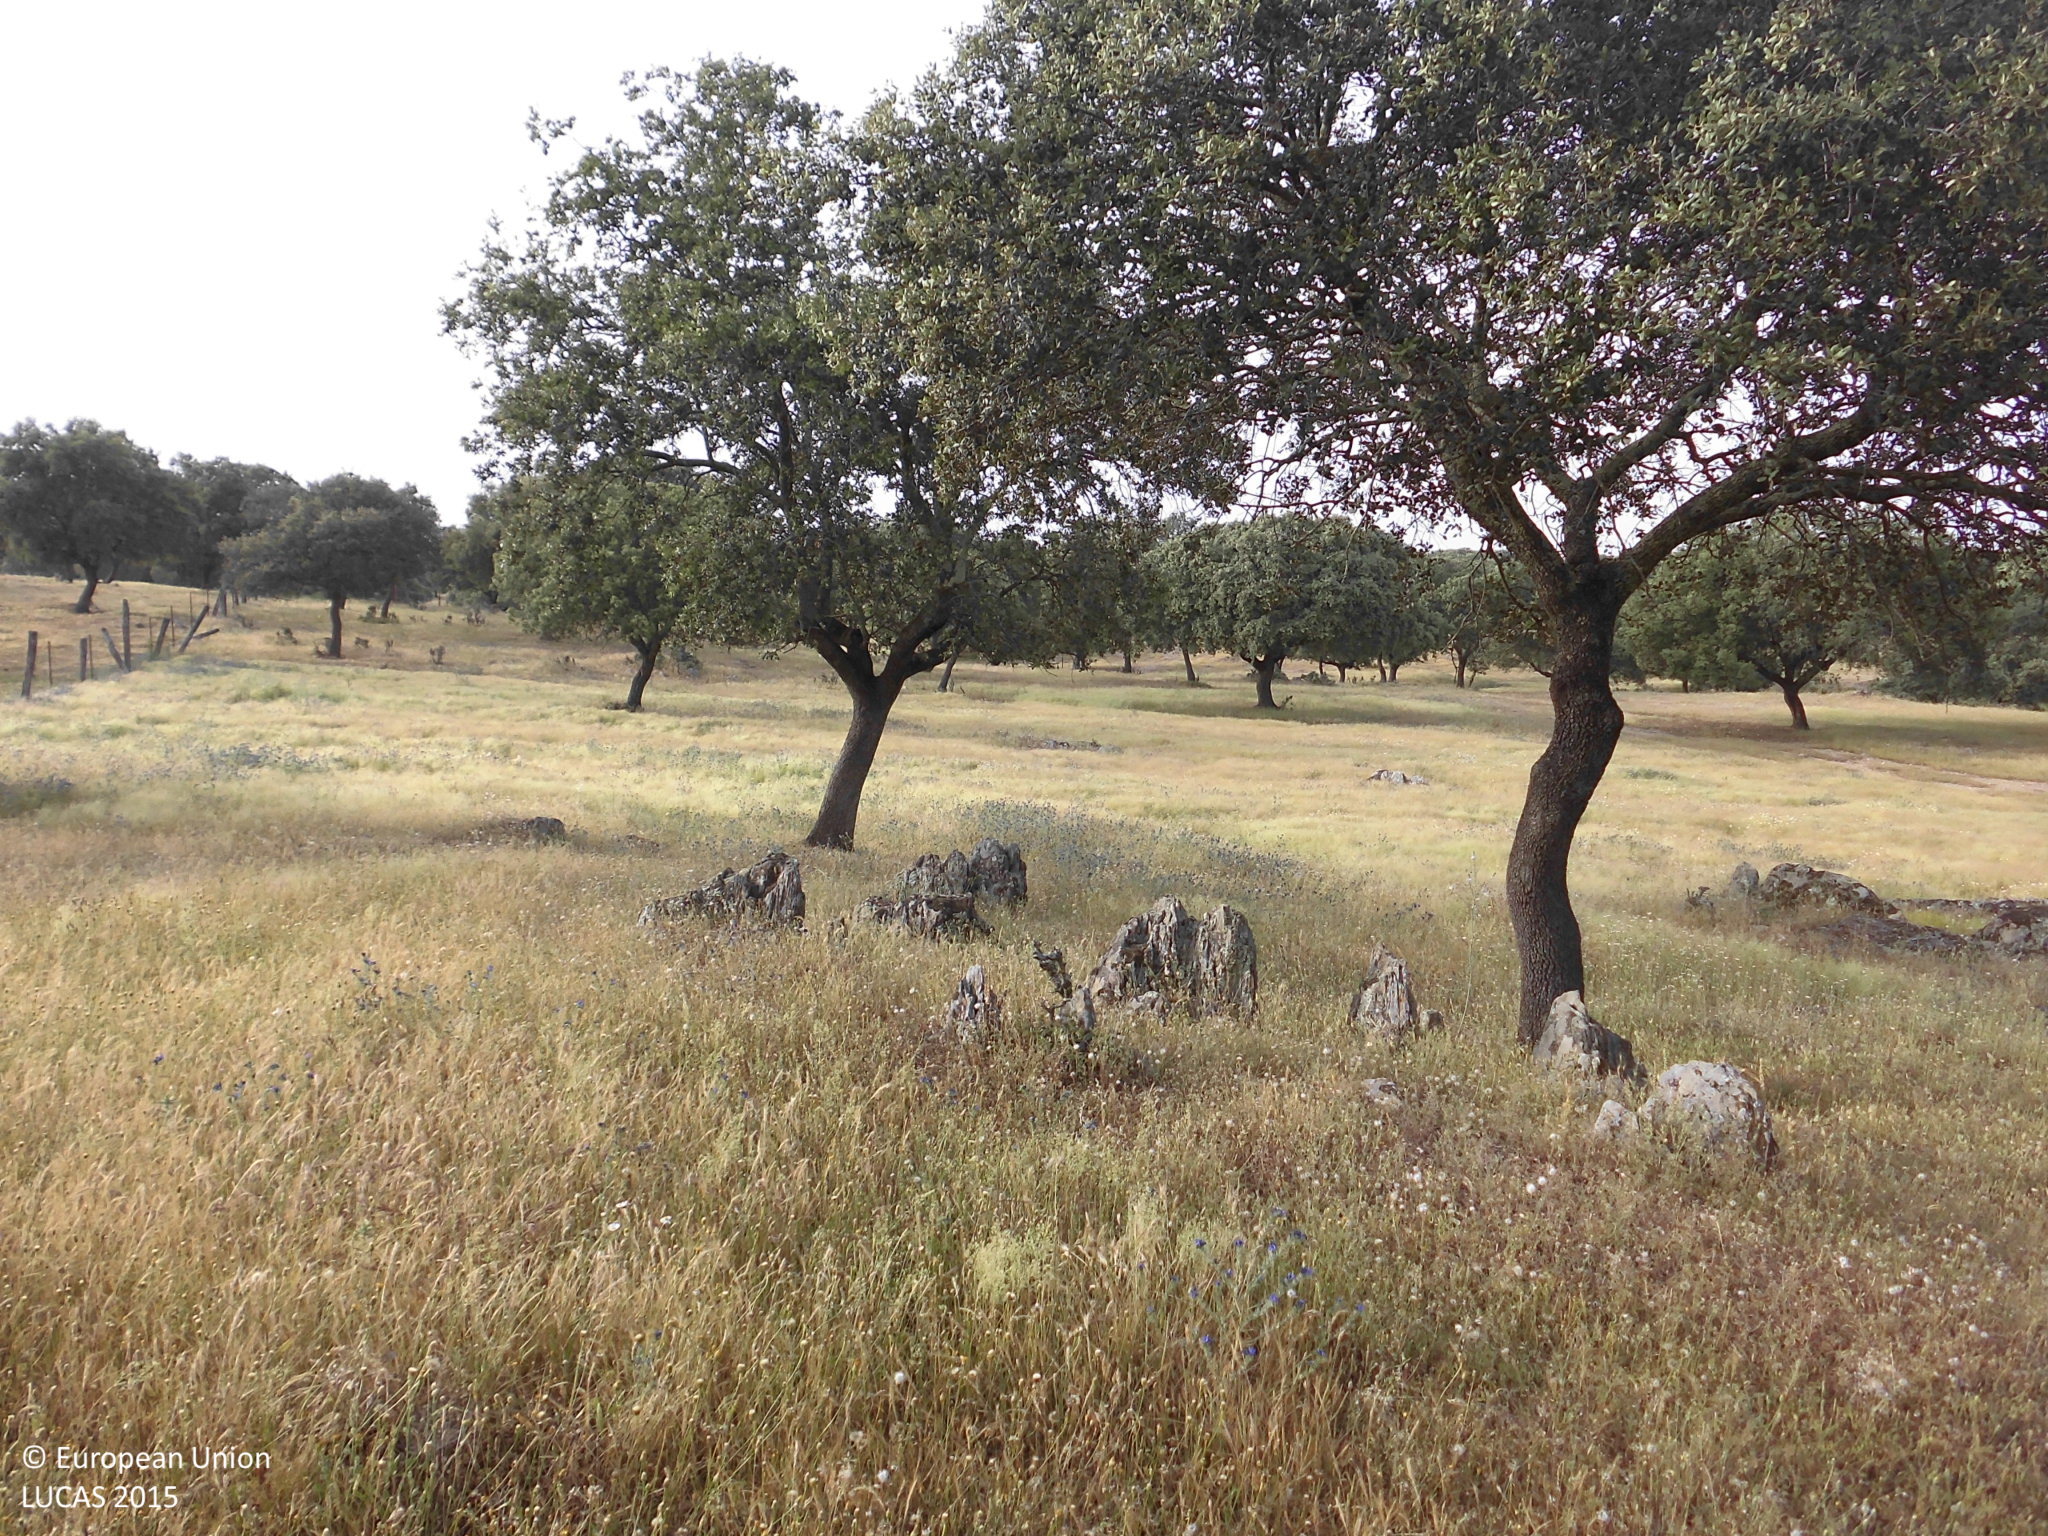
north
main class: Woodland
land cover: Broadleaved woodland
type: broadleaved evergreen forest
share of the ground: 25 - 50 %
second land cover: Grassland without tree/shrub cover
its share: > 75 %
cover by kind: shrubs 65 %, broadleaved forest trees 35 %
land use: Forestry
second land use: Agriculture (excluding fallow land and kitchen gardens)
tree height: > 5 m
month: May
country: ES
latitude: 39.6475
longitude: -6.0889
